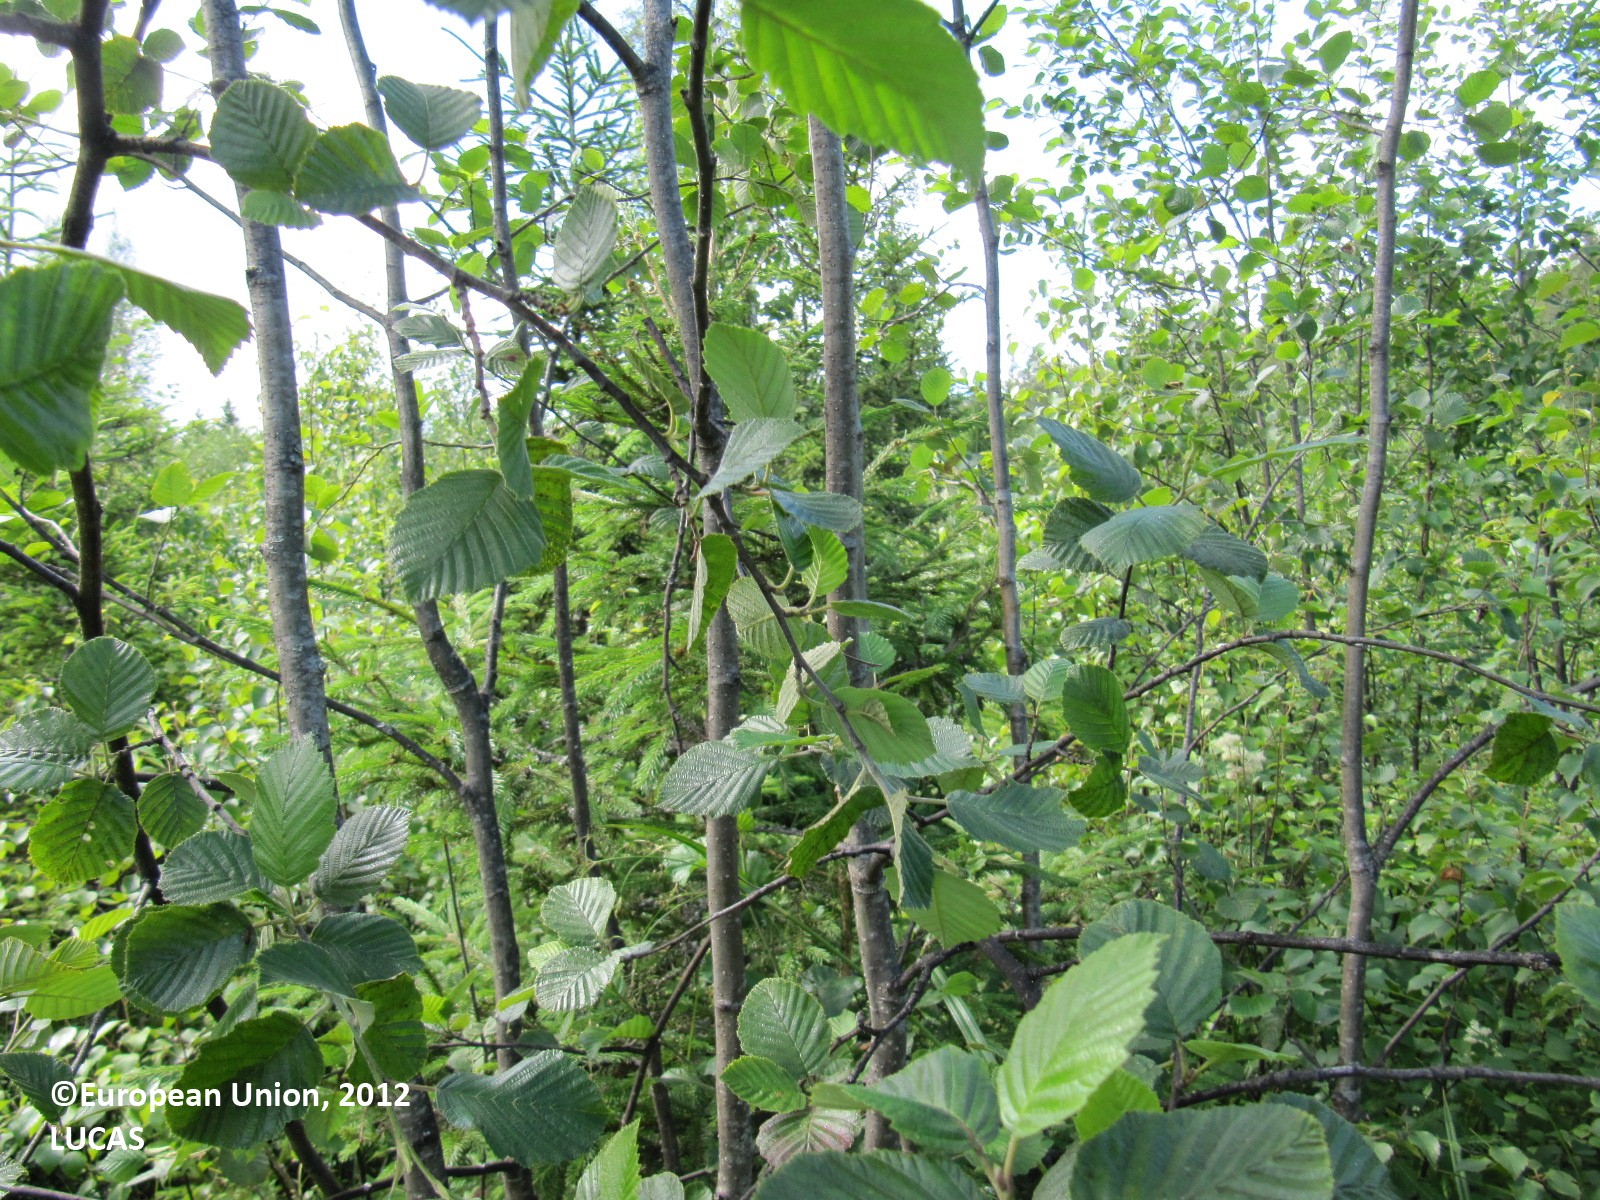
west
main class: Woodland
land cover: Broadleaved woodland
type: boreal forest
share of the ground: > 75 %
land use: Forestry
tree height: < 5 m
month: July
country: FI
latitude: 60.9800
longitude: 24.1961
